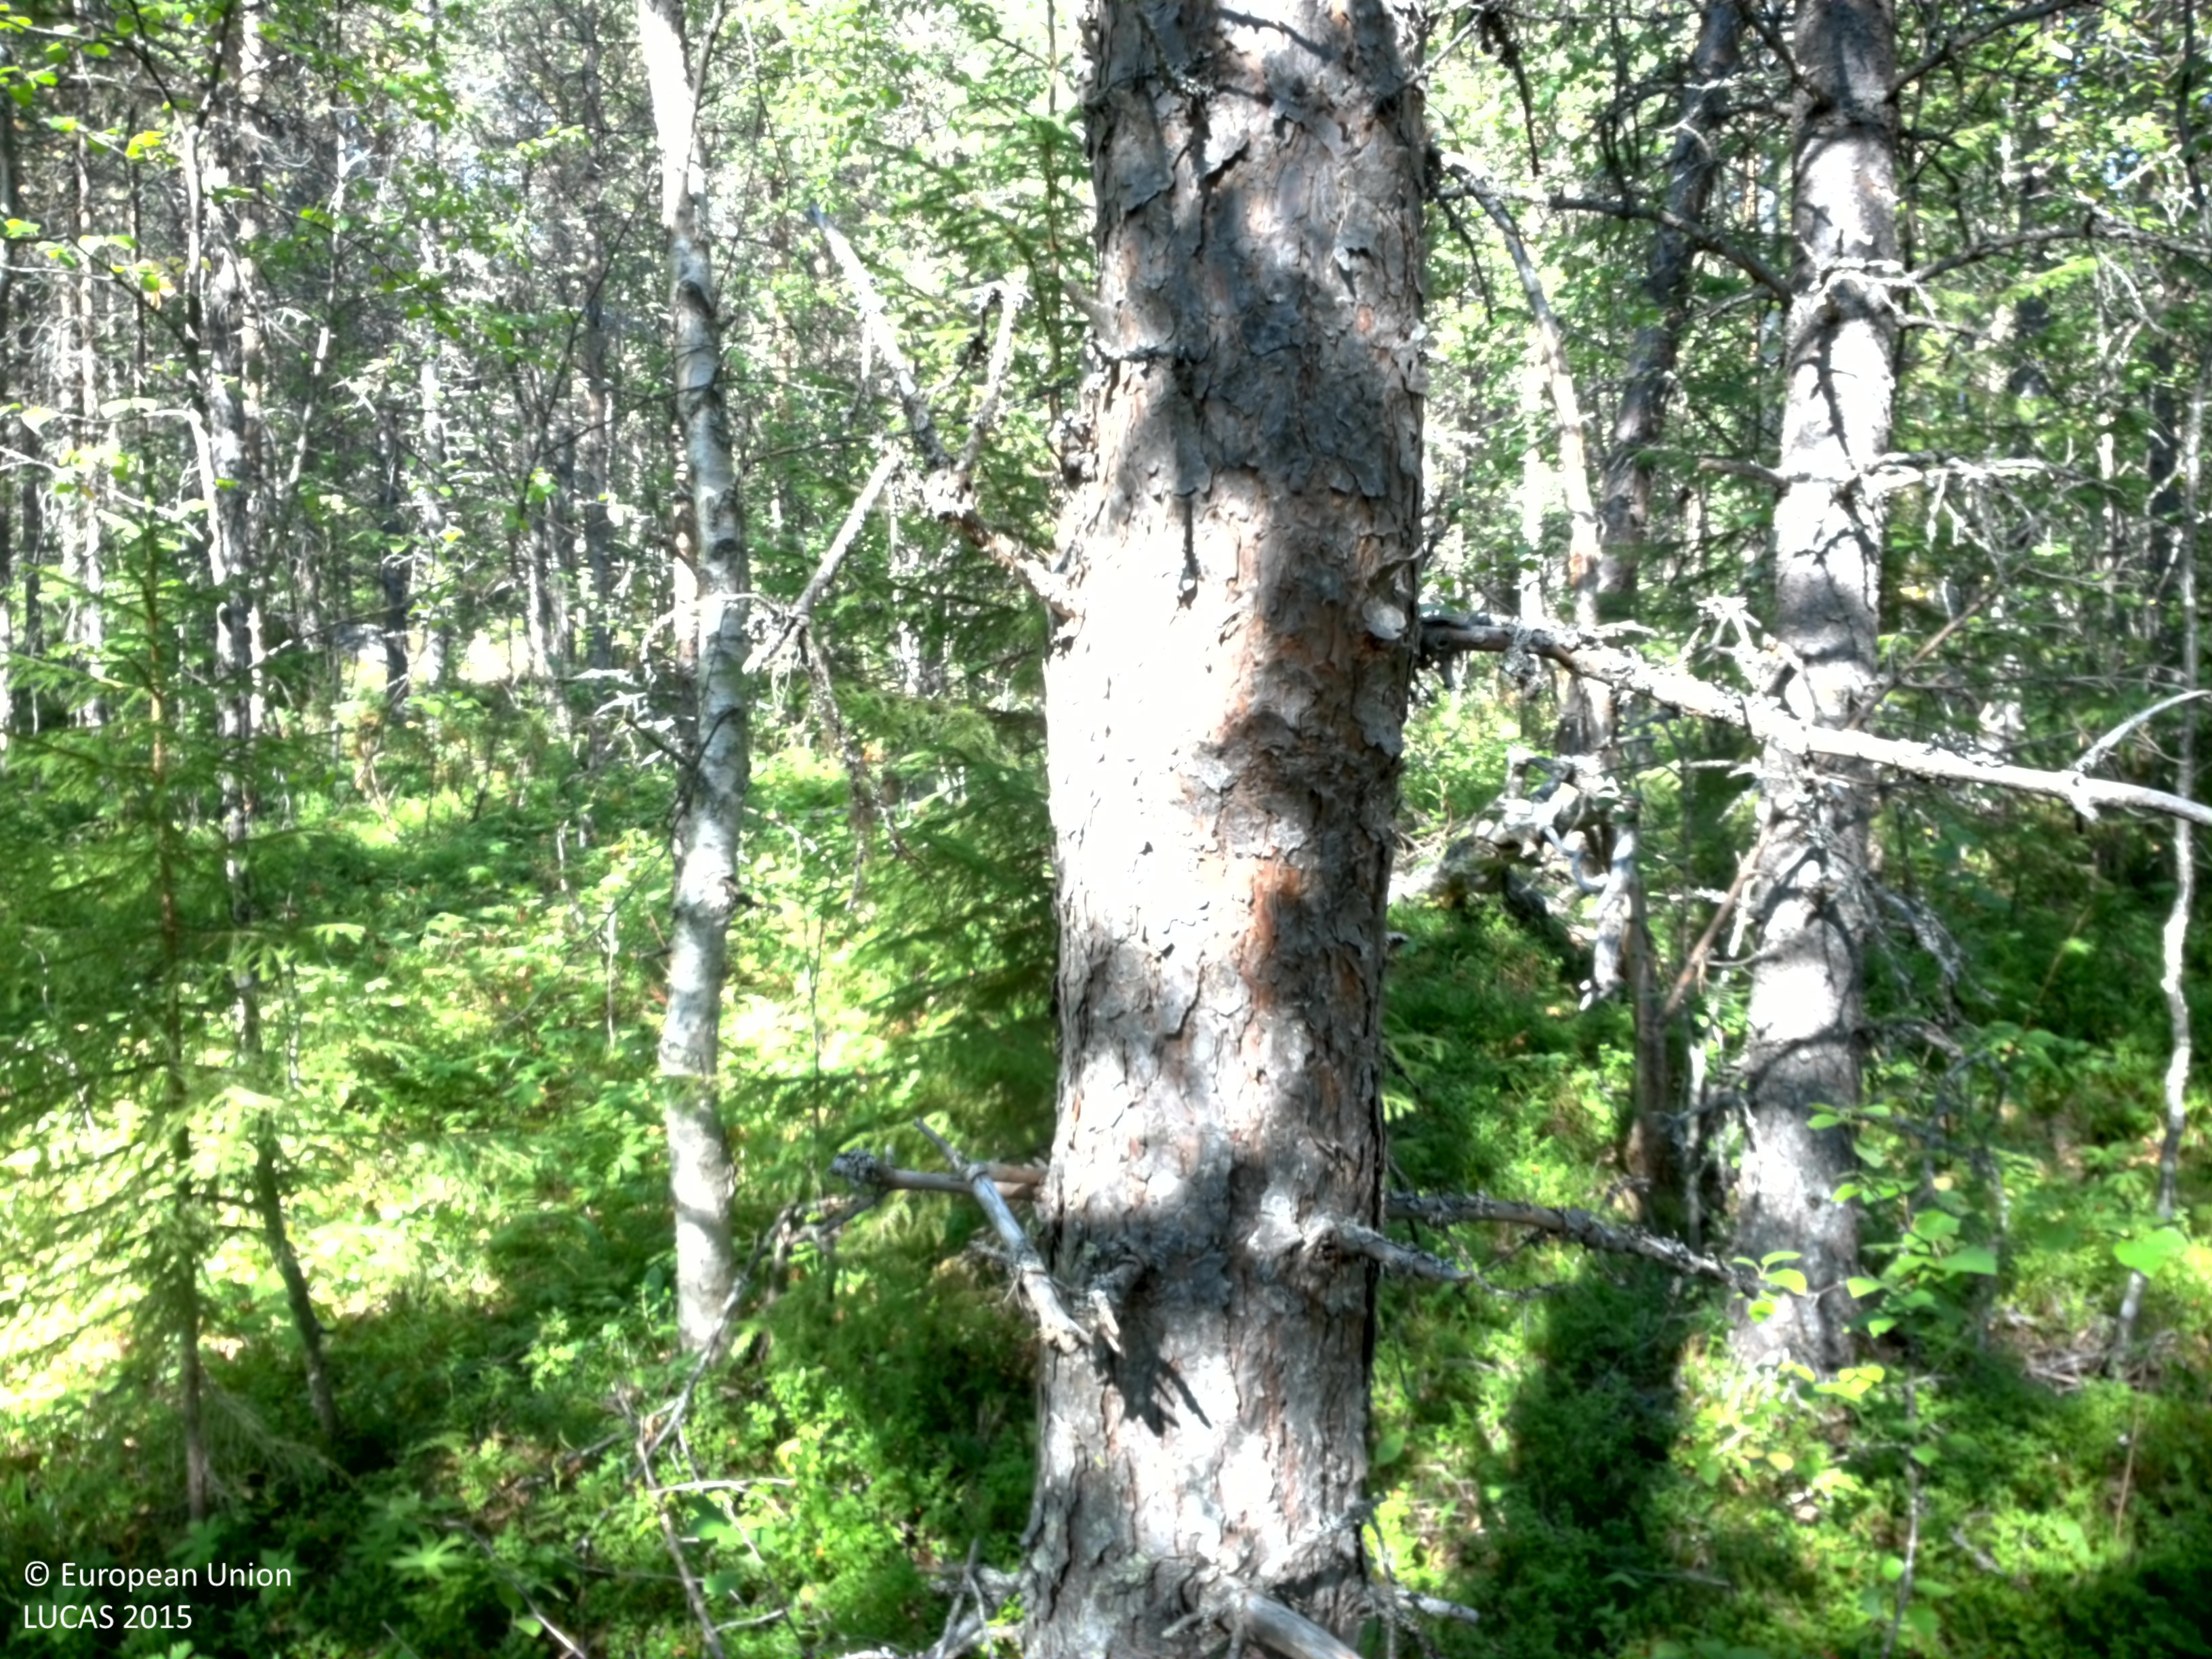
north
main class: Woodland
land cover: Pine dominated mixed woodland
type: boreal forest
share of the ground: 50 - 75 %
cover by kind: coniferous forest trees 35 %, broadleaved forest trees 30 %, shrubs 25 %, herbaceous plants 10 %
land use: Forestry
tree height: > 5 m
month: August
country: SE
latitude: 64.6740
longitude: 16.6920
